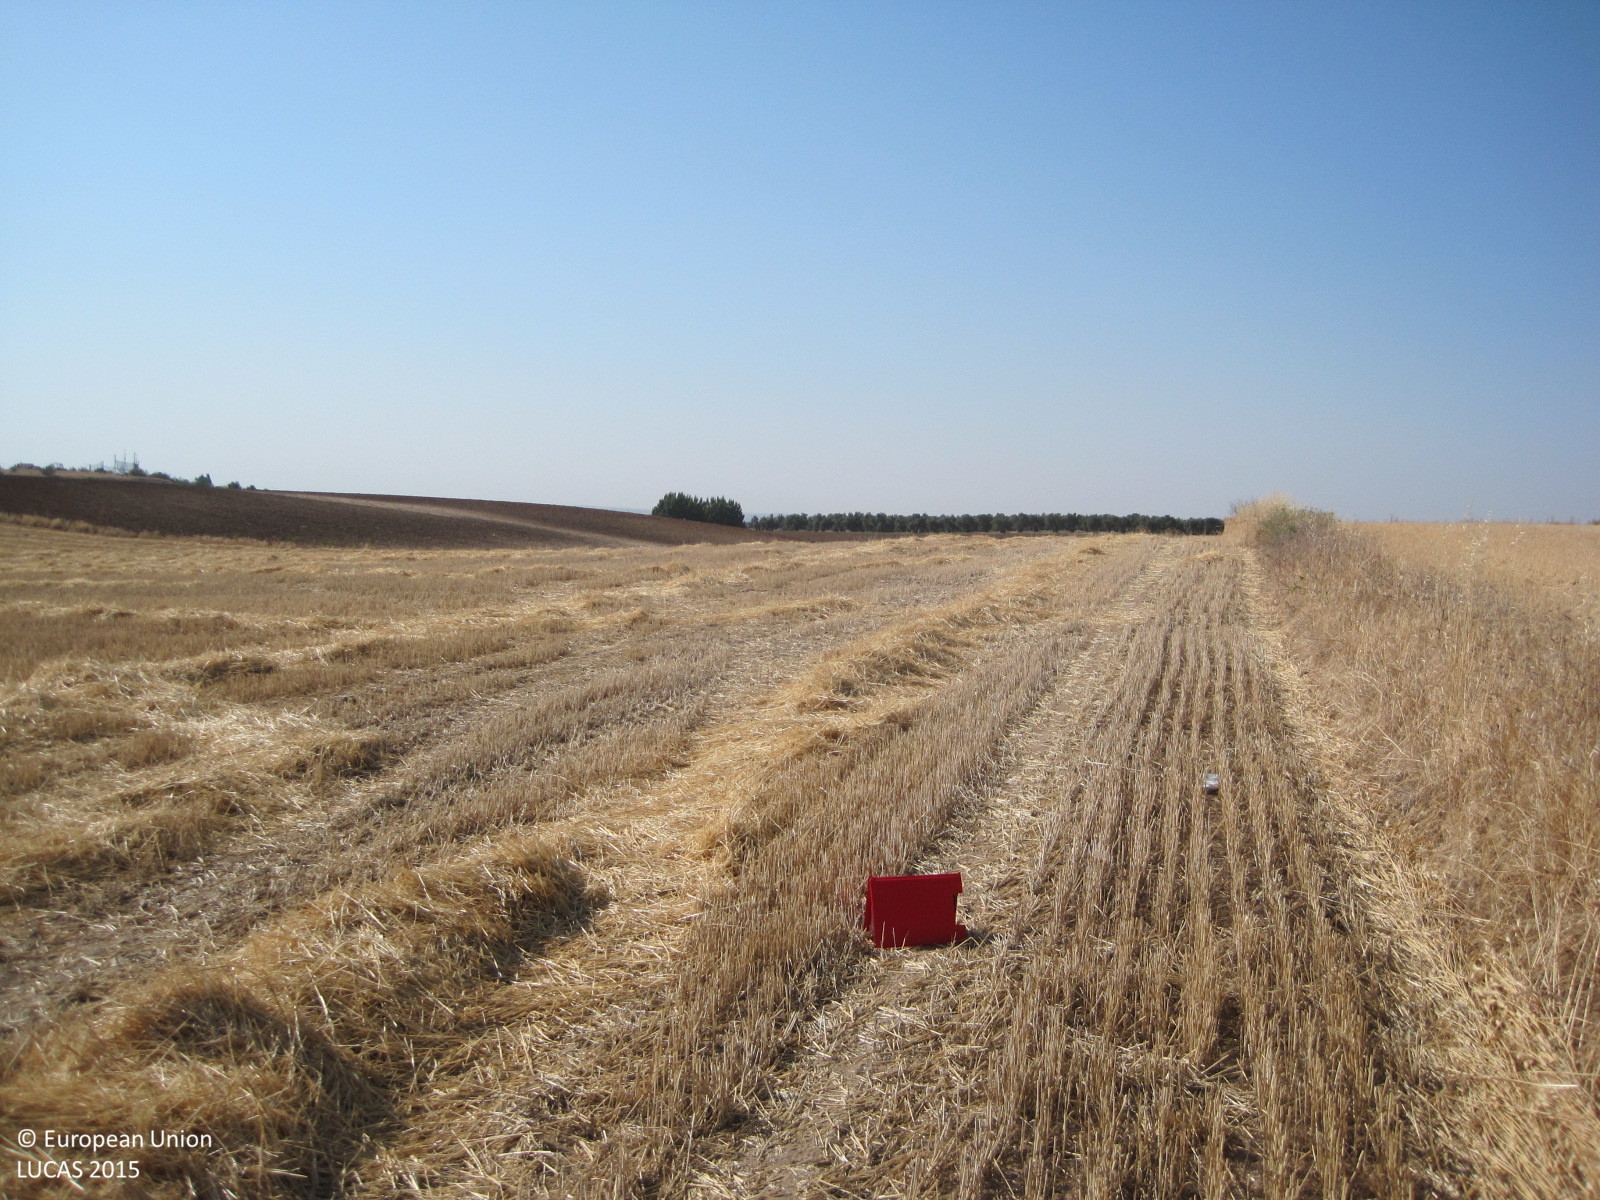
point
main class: Cropland
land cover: Common wheat
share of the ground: < 10 %
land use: Agriculture (excluding fallow land and kitchen gardens)
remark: Harvested field
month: July
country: ES
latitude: 40.1587
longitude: -3.8547
